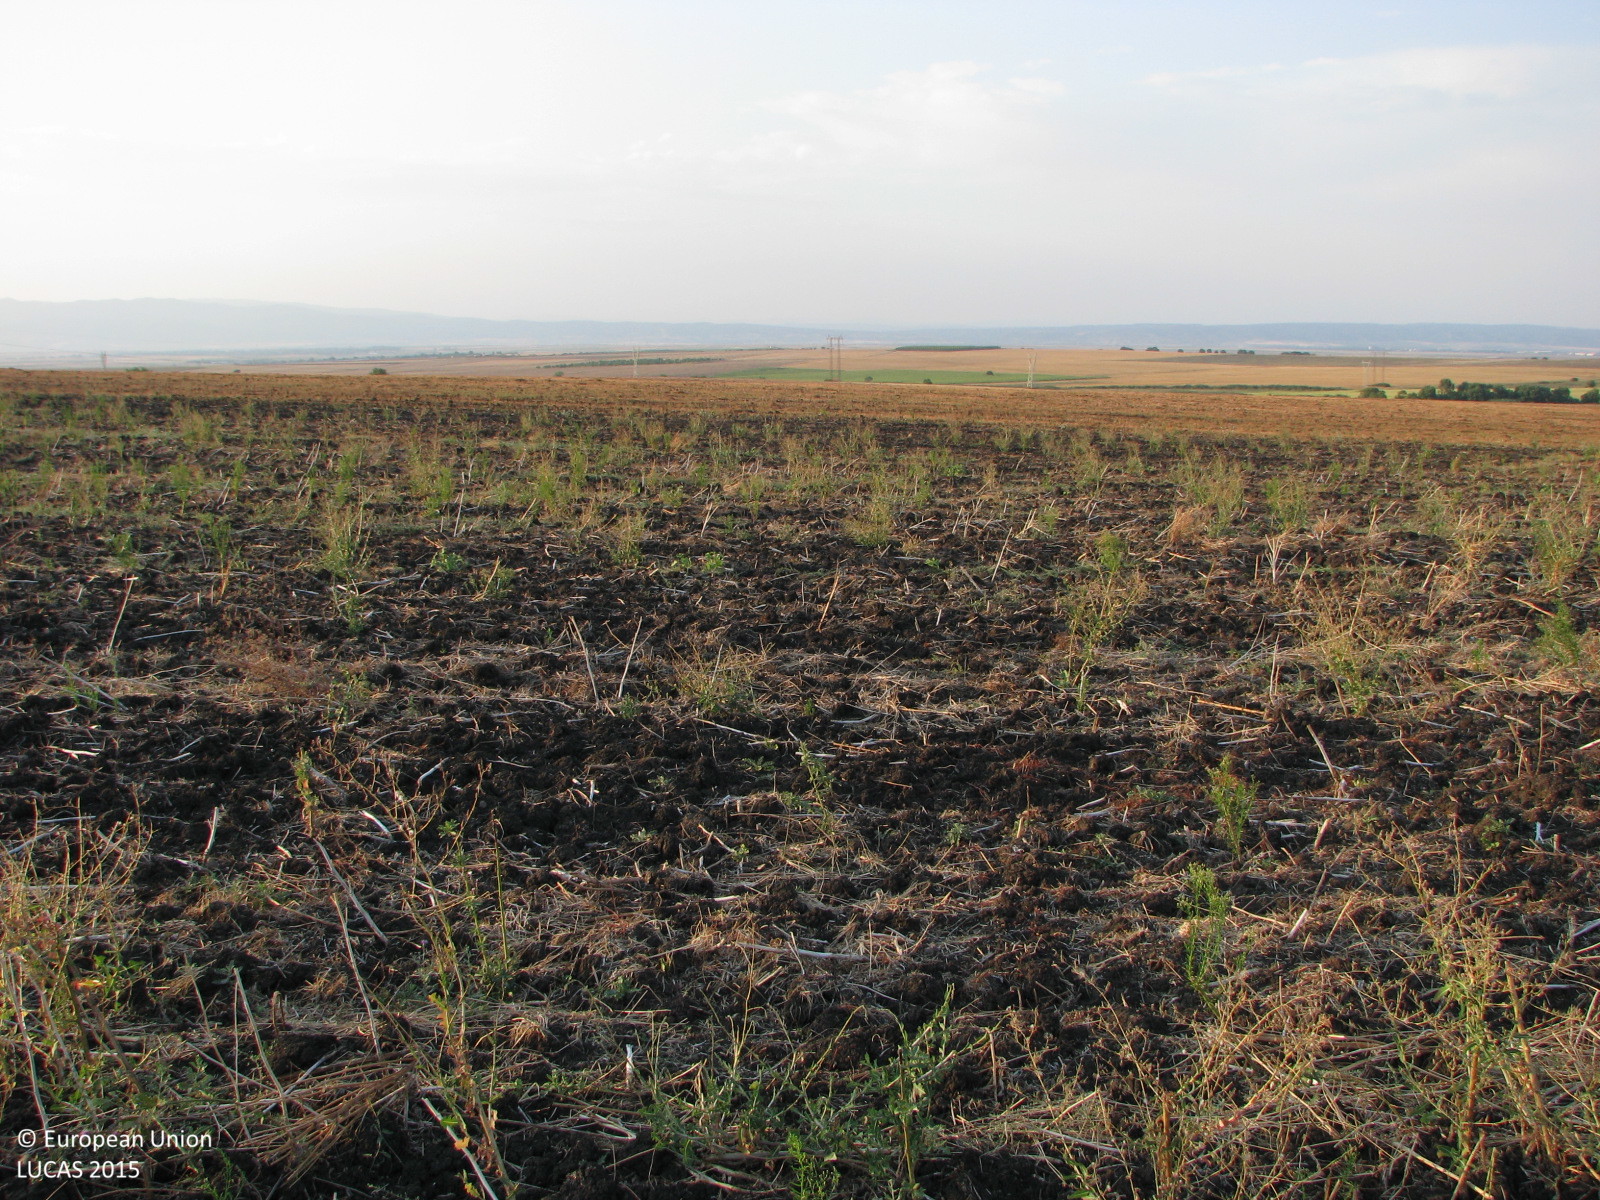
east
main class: Cropland
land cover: Barley
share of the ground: < 10 %
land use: Agriculture (excluding fallow land and kitchen gardens)
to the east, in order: Barley
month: August
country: BG
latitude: 42.5002
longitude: 26.6326
